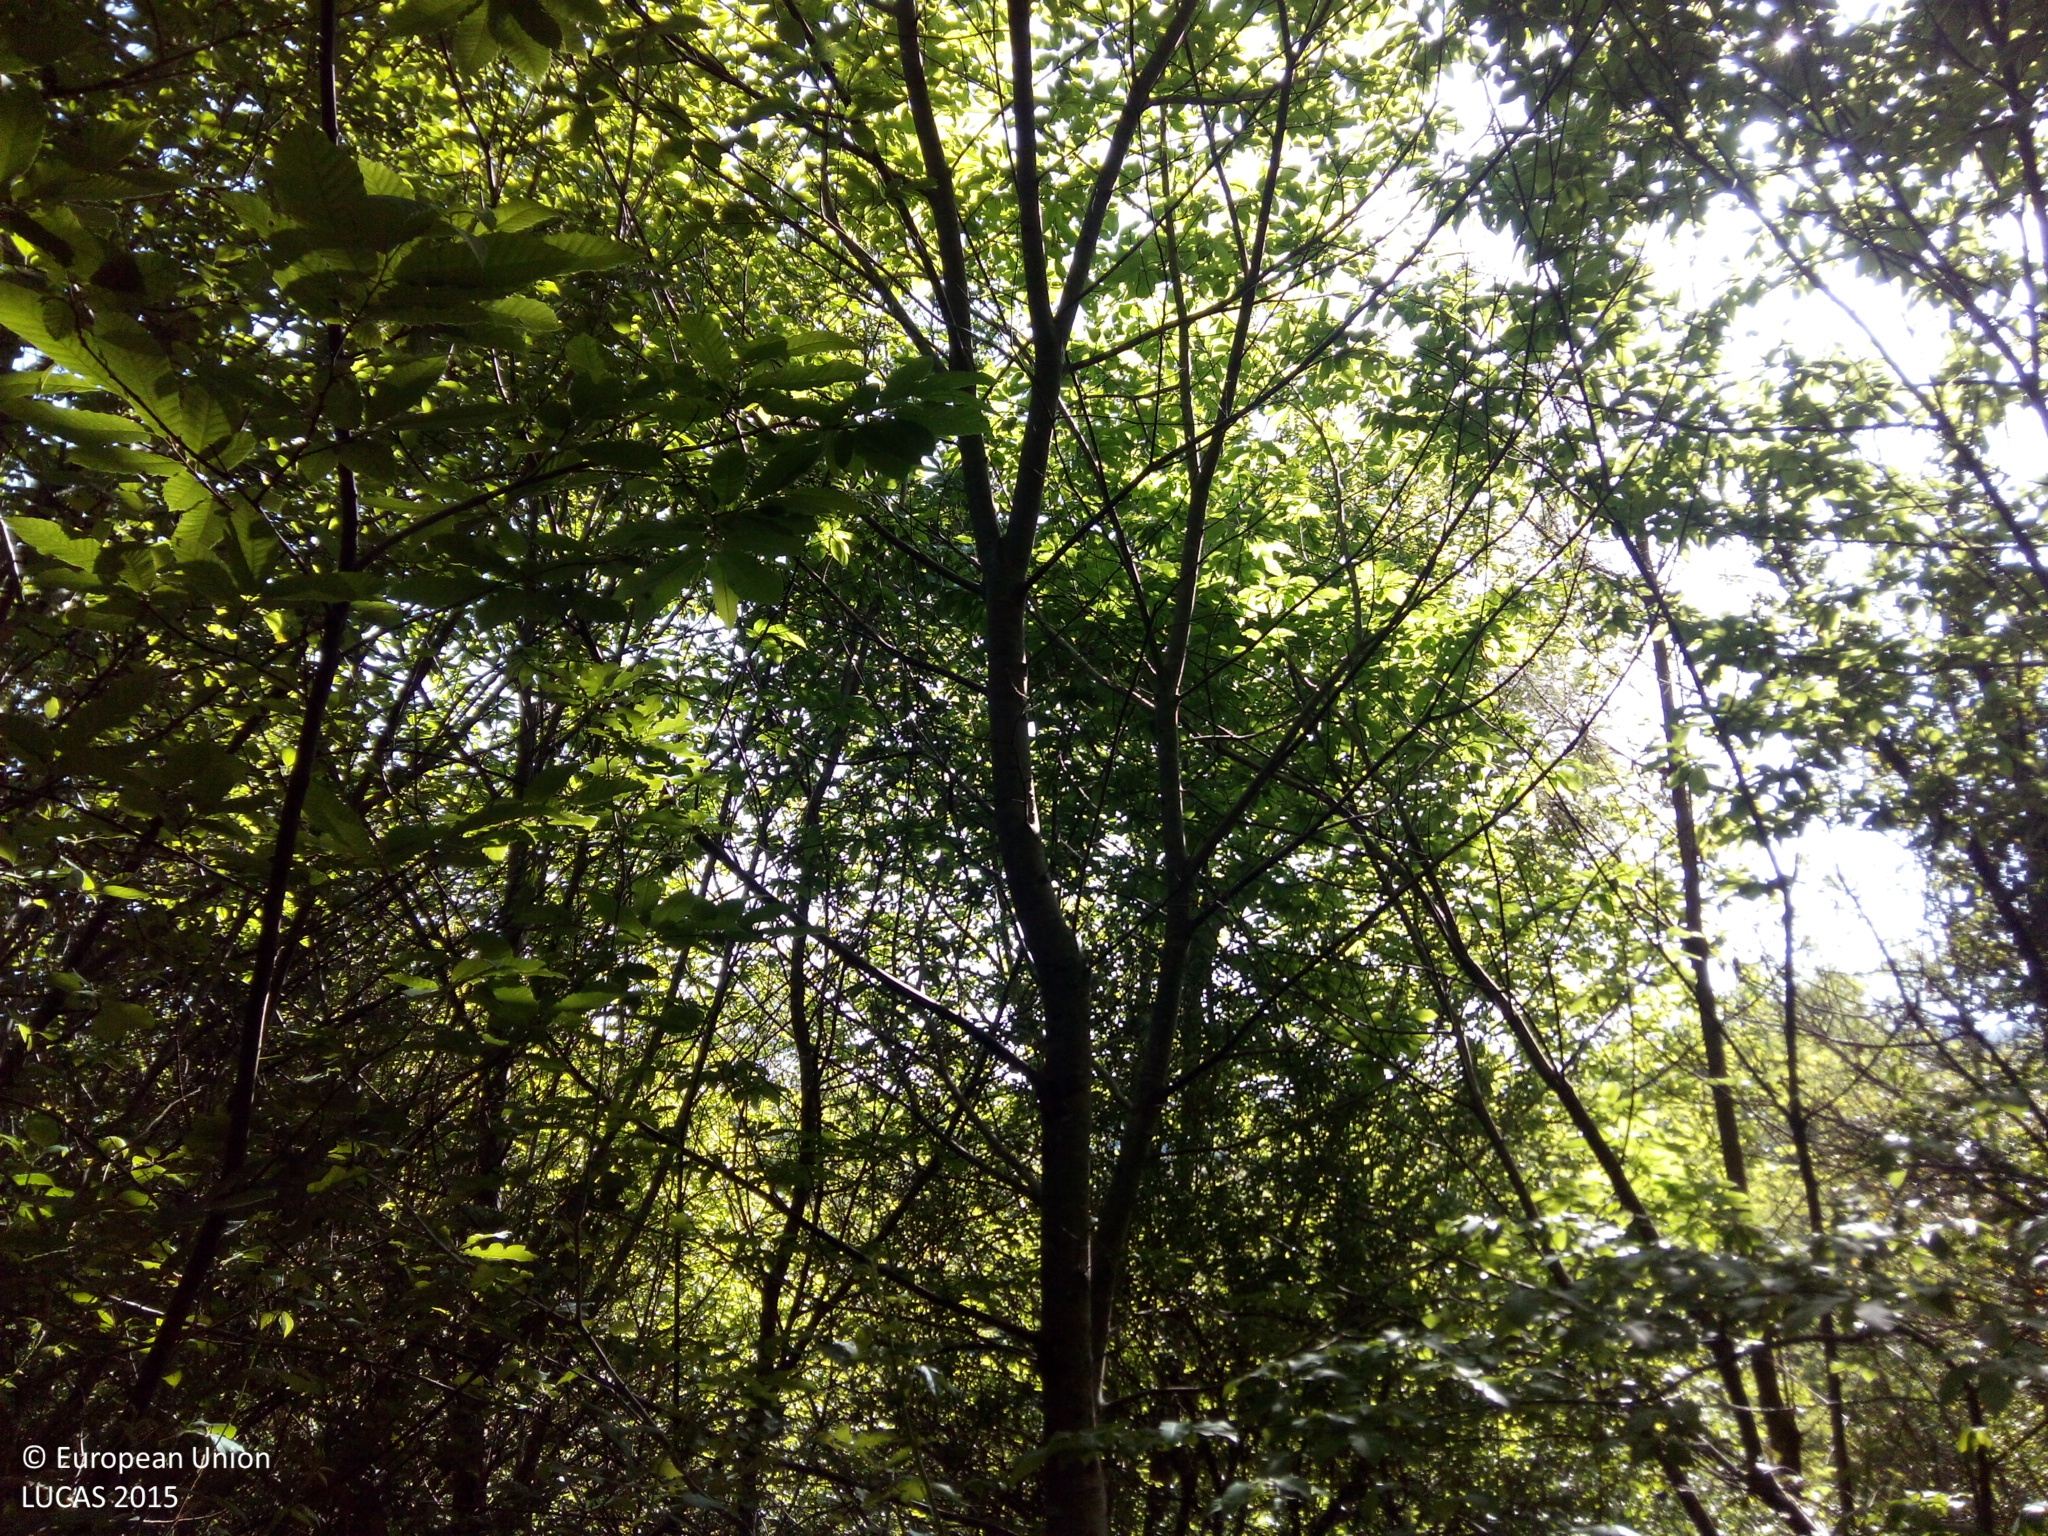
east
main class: Woodland
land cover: Broadleaved woodland
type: acidophilous oak and oak-birch forest
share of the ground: > 75 %
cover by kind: broadleaved forest trees 100 %
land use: Forestry
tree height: > 5 m
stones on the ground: 10 - 25 %
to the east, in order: Broadleaved woodland; Rivers and streams; Artificial constructions; Broadleaved woodland; Artificial constructions; Shrubland without tree cover; Mixed cereals for fodder; Spontaneously vegetated surfaces; Other bare soil; Maize
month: May
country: ES
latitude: 42.6800
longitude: -8.4408
